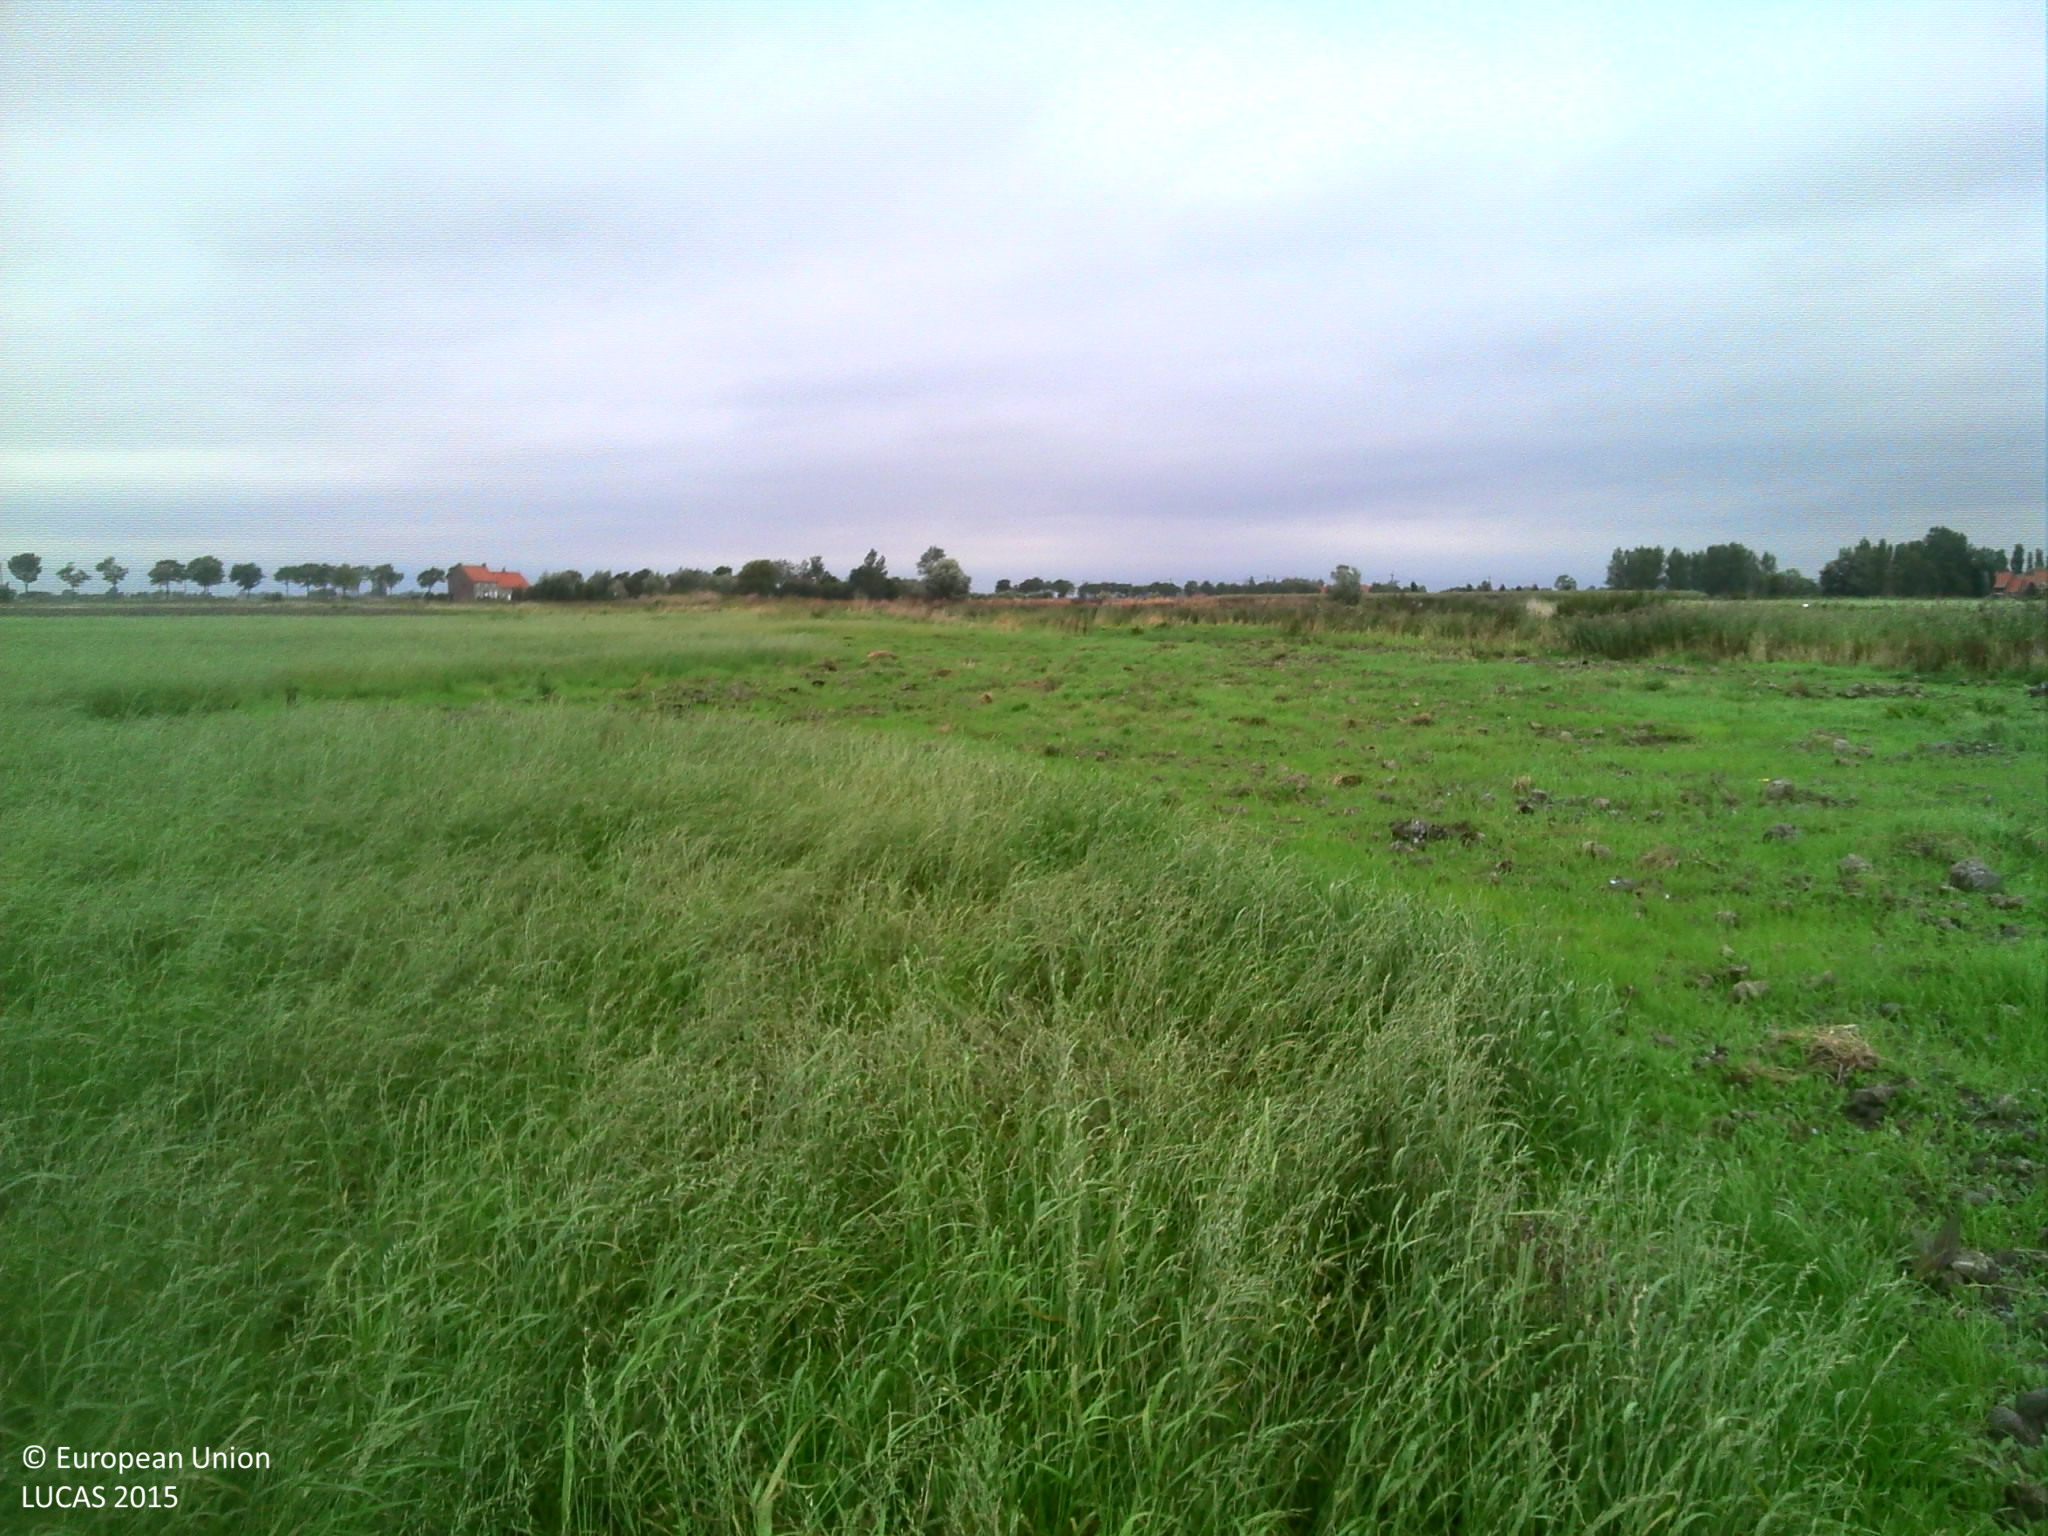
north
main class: Cropland
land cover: Temporary grasslands
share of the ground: > 75 %
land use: Agriculture (excluding fallow land and kitchen gardens)
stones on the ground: < 10 %
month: September
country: BE
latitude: 51.0764
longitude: 2.8095
